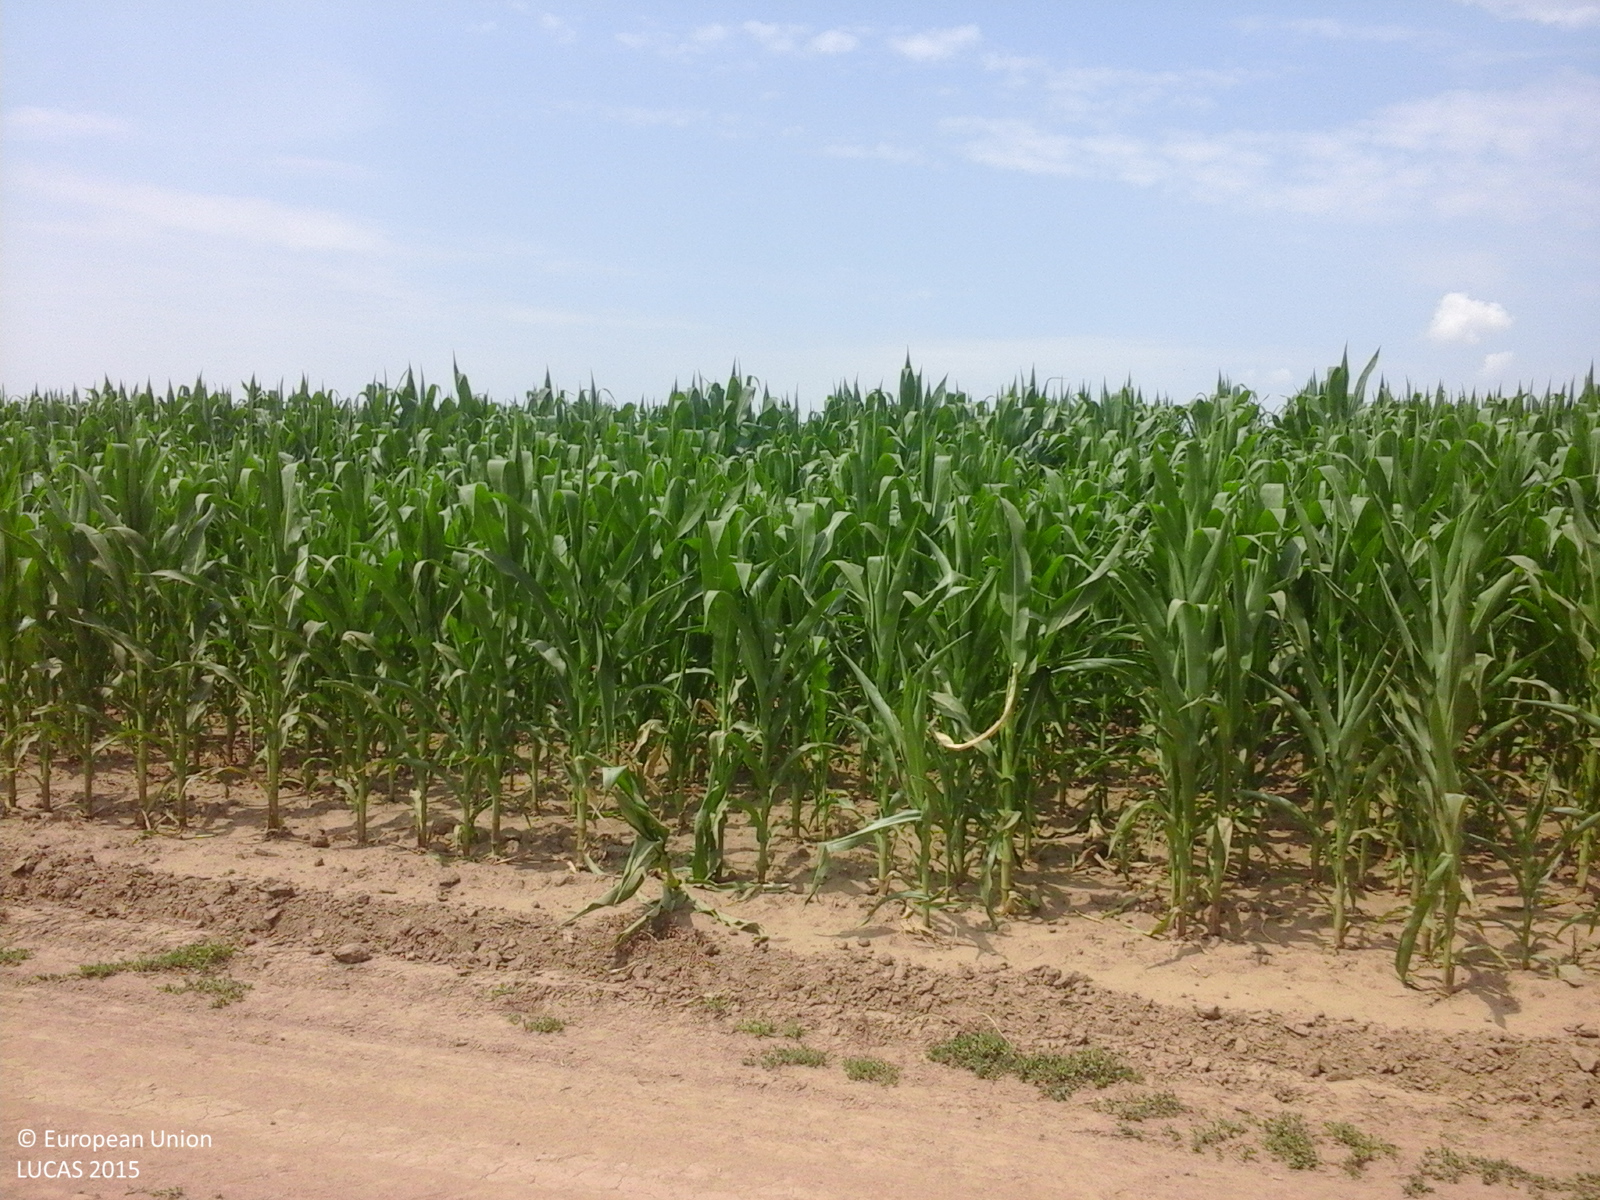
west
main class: Cropland
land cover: Common wheat
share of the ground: > 75 %
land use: Agriculture (excluding fallow land and kitchen gardens)
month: July
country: RO
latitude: 44.1788
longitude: 26.4855
